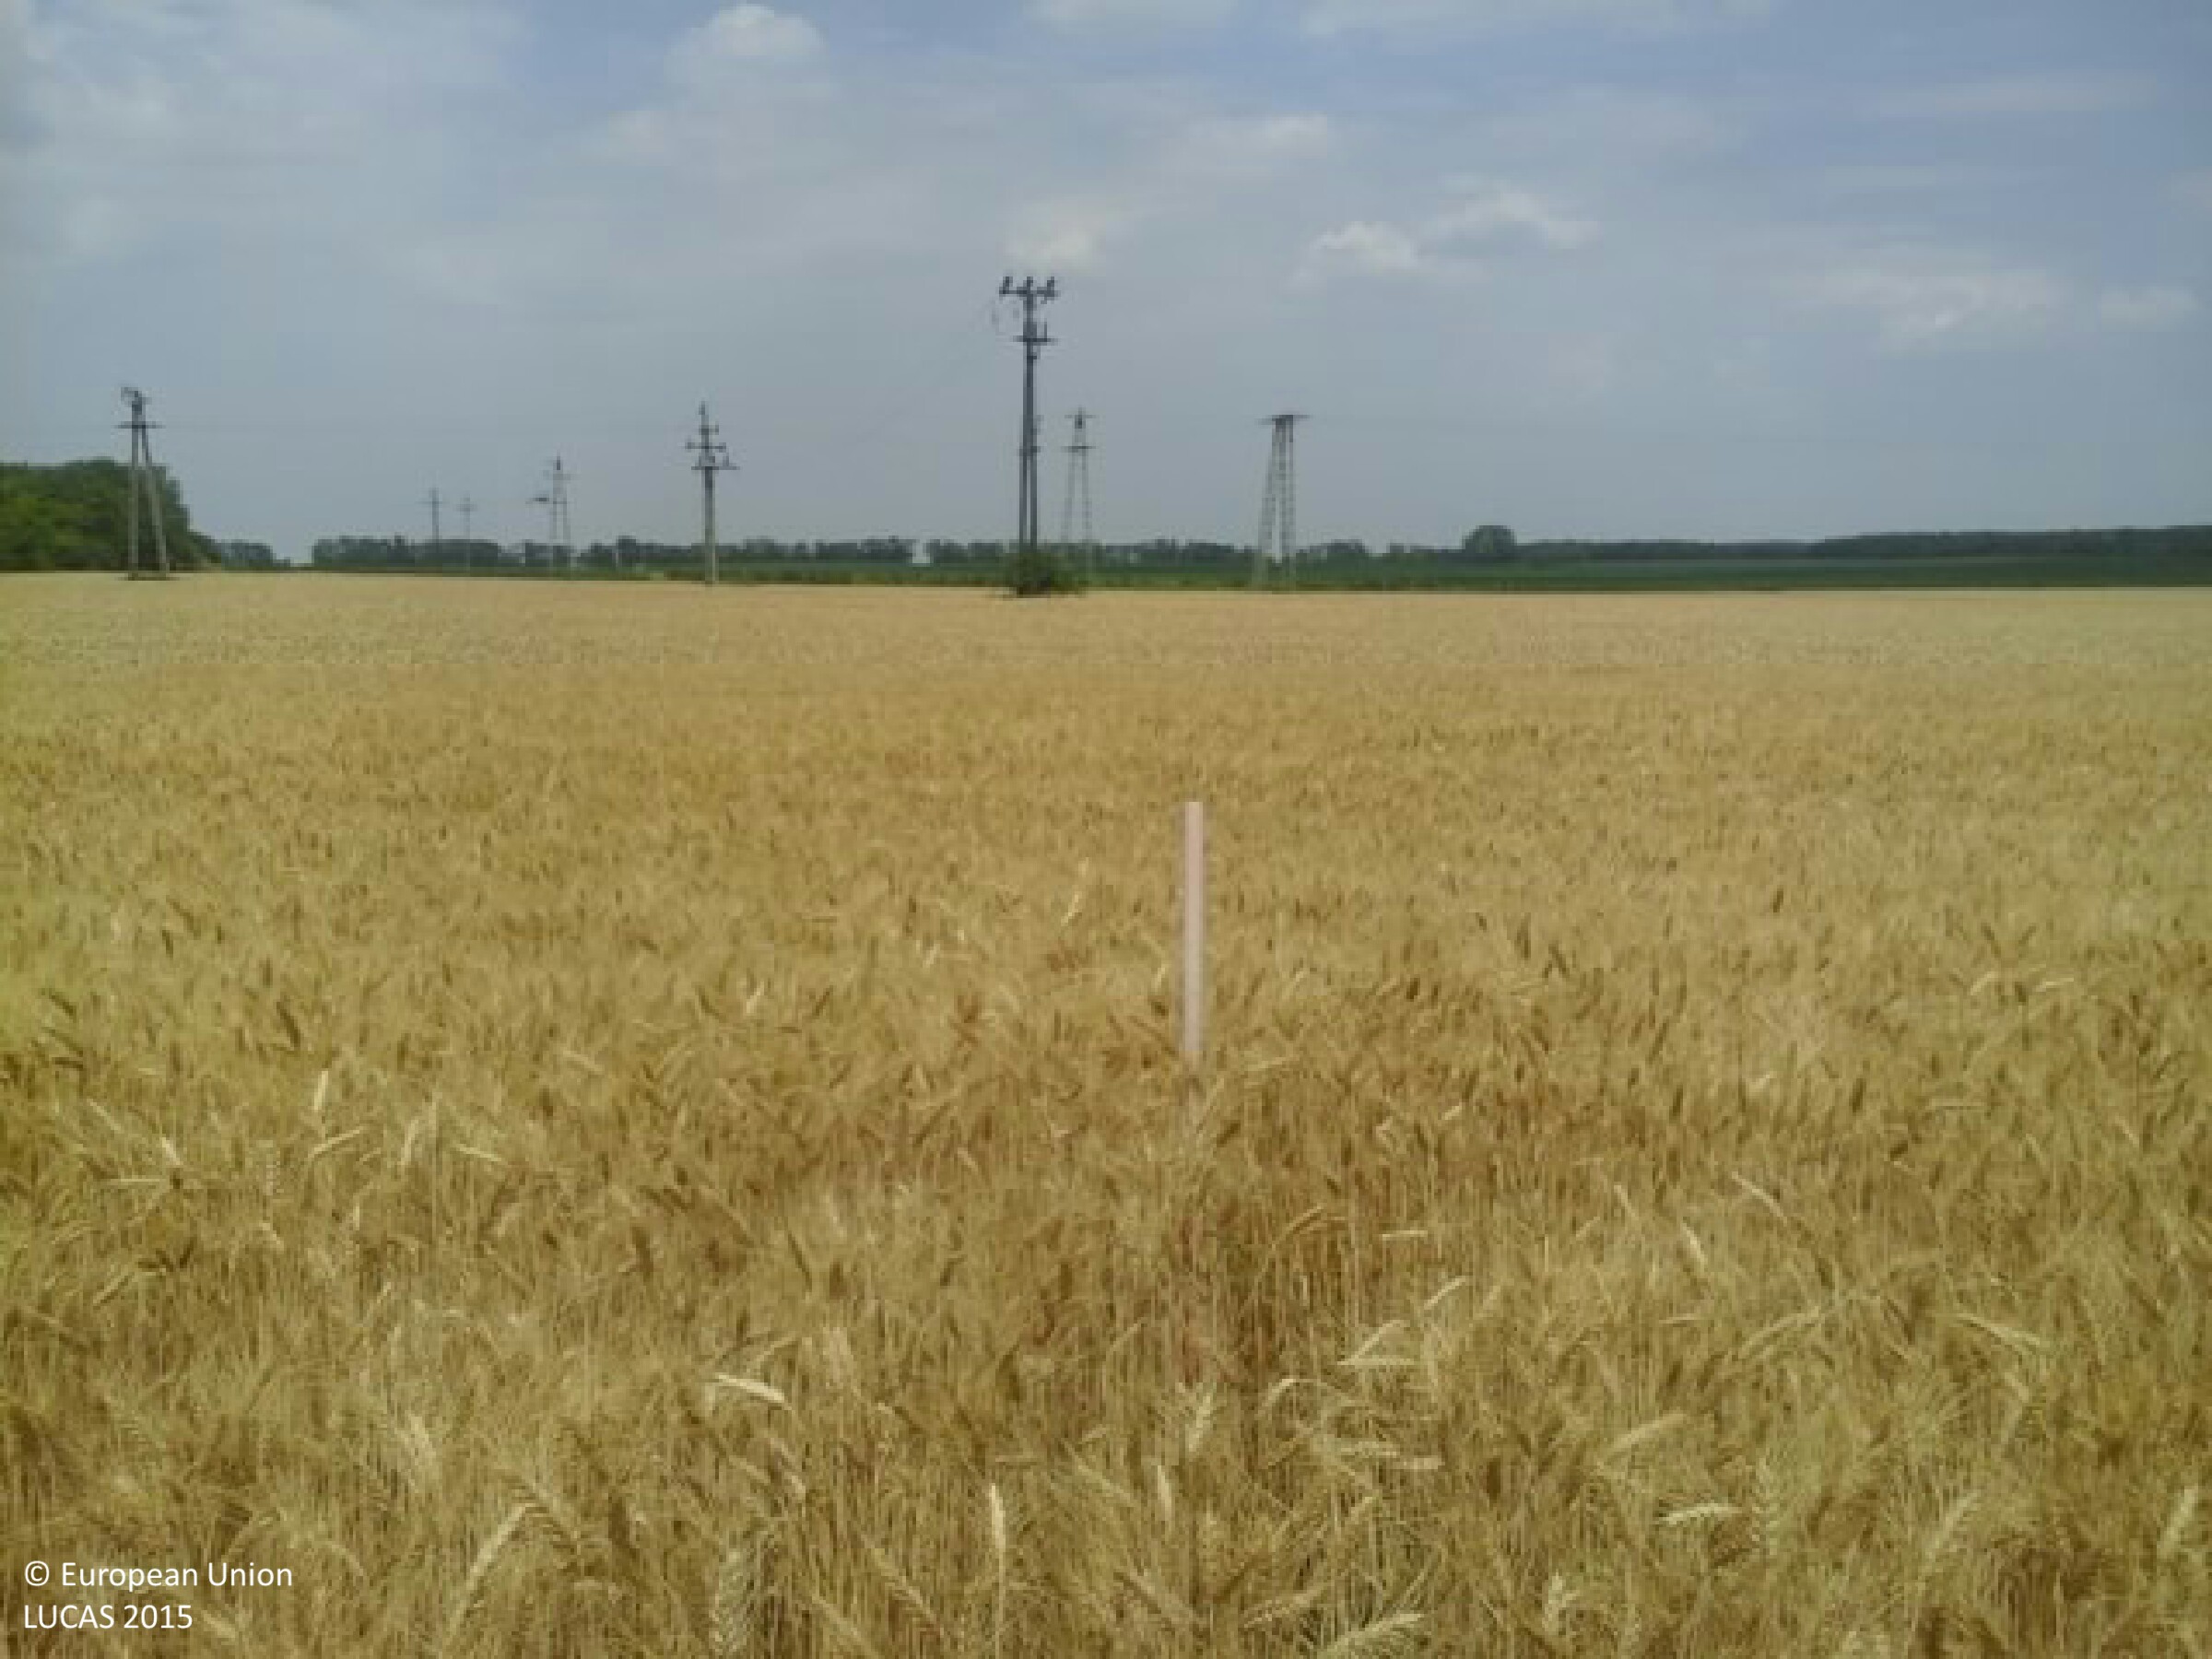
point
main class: Cropland
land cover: Common wheat
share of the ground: > 75 %
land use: Agriculture (excluding fallow land and kitchen gardens)
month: July
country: HU
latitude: 46.7403
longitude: 18.9006
